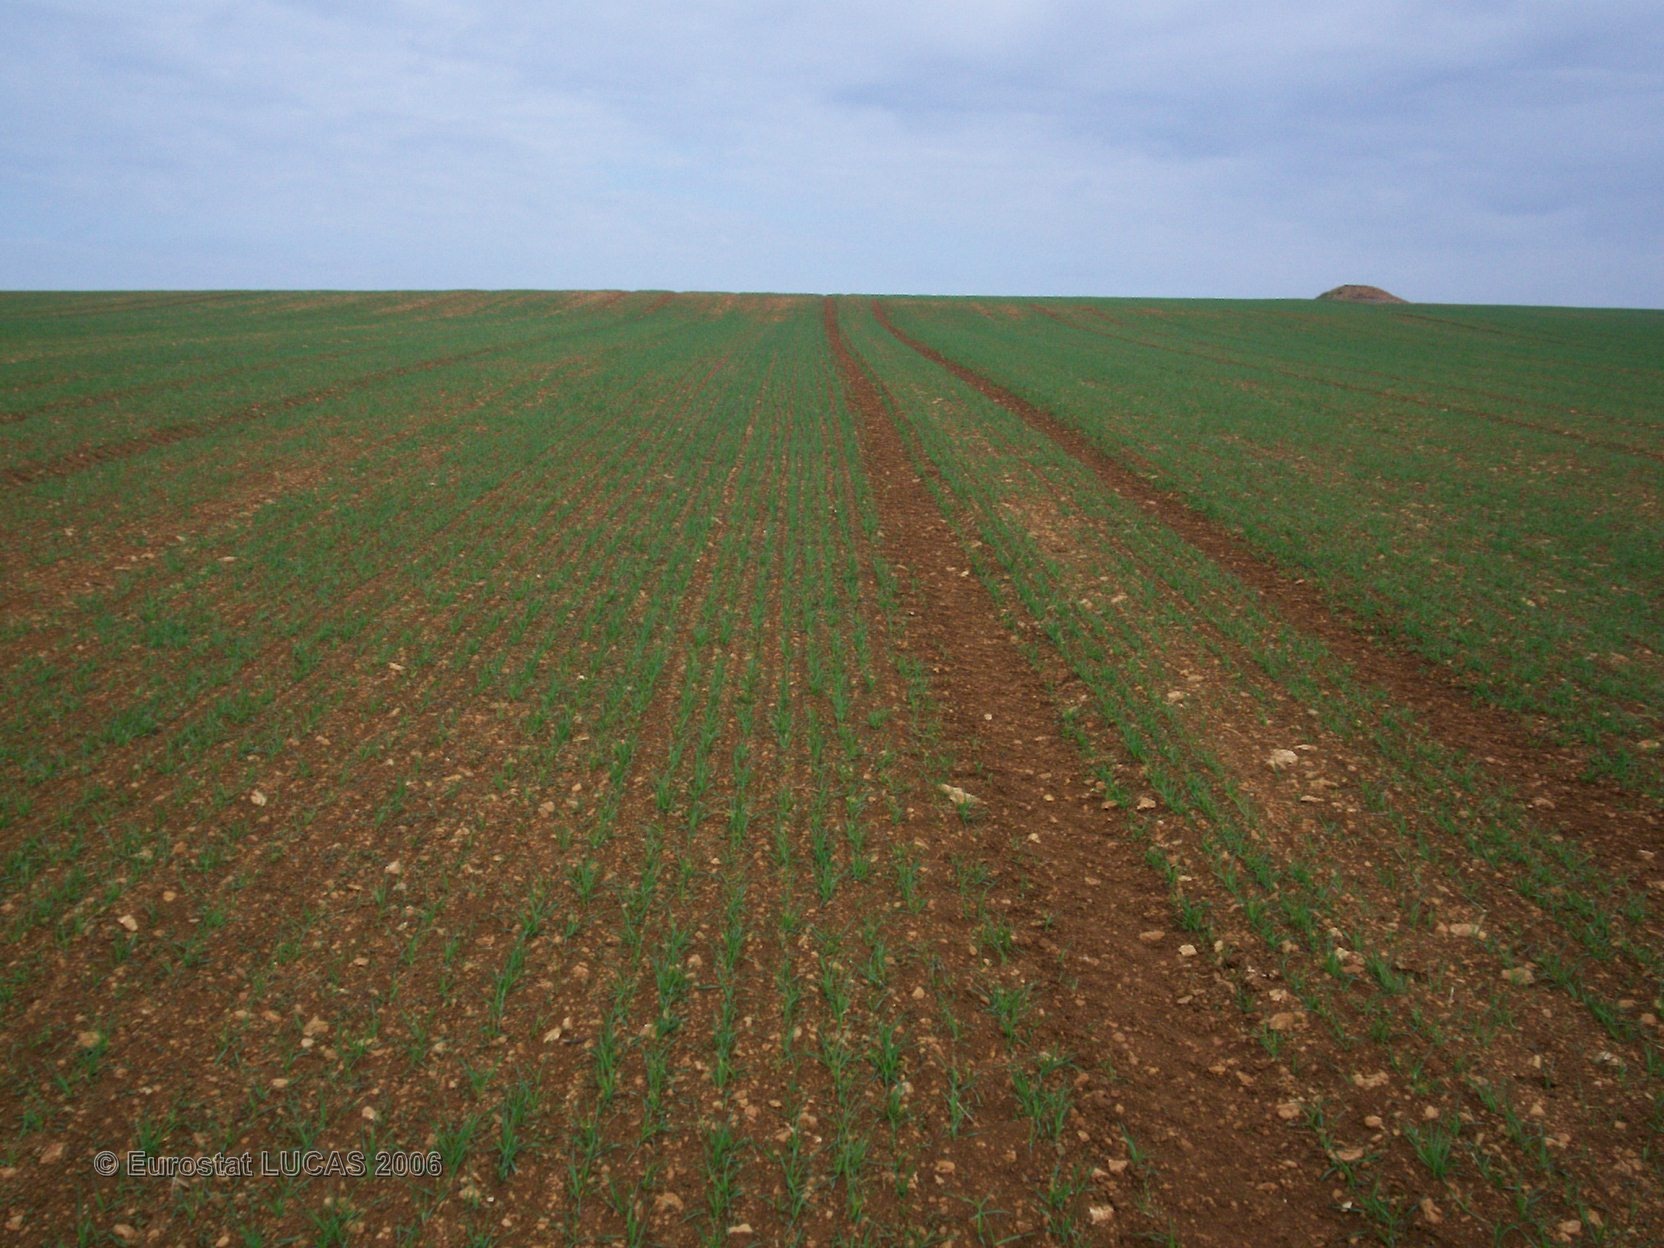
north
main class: Cropland
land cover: Barley
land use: Agriculture (excluding fallow land and kitchen gardens)
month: April
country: FR
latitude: 48.8518
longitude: 5.9520
